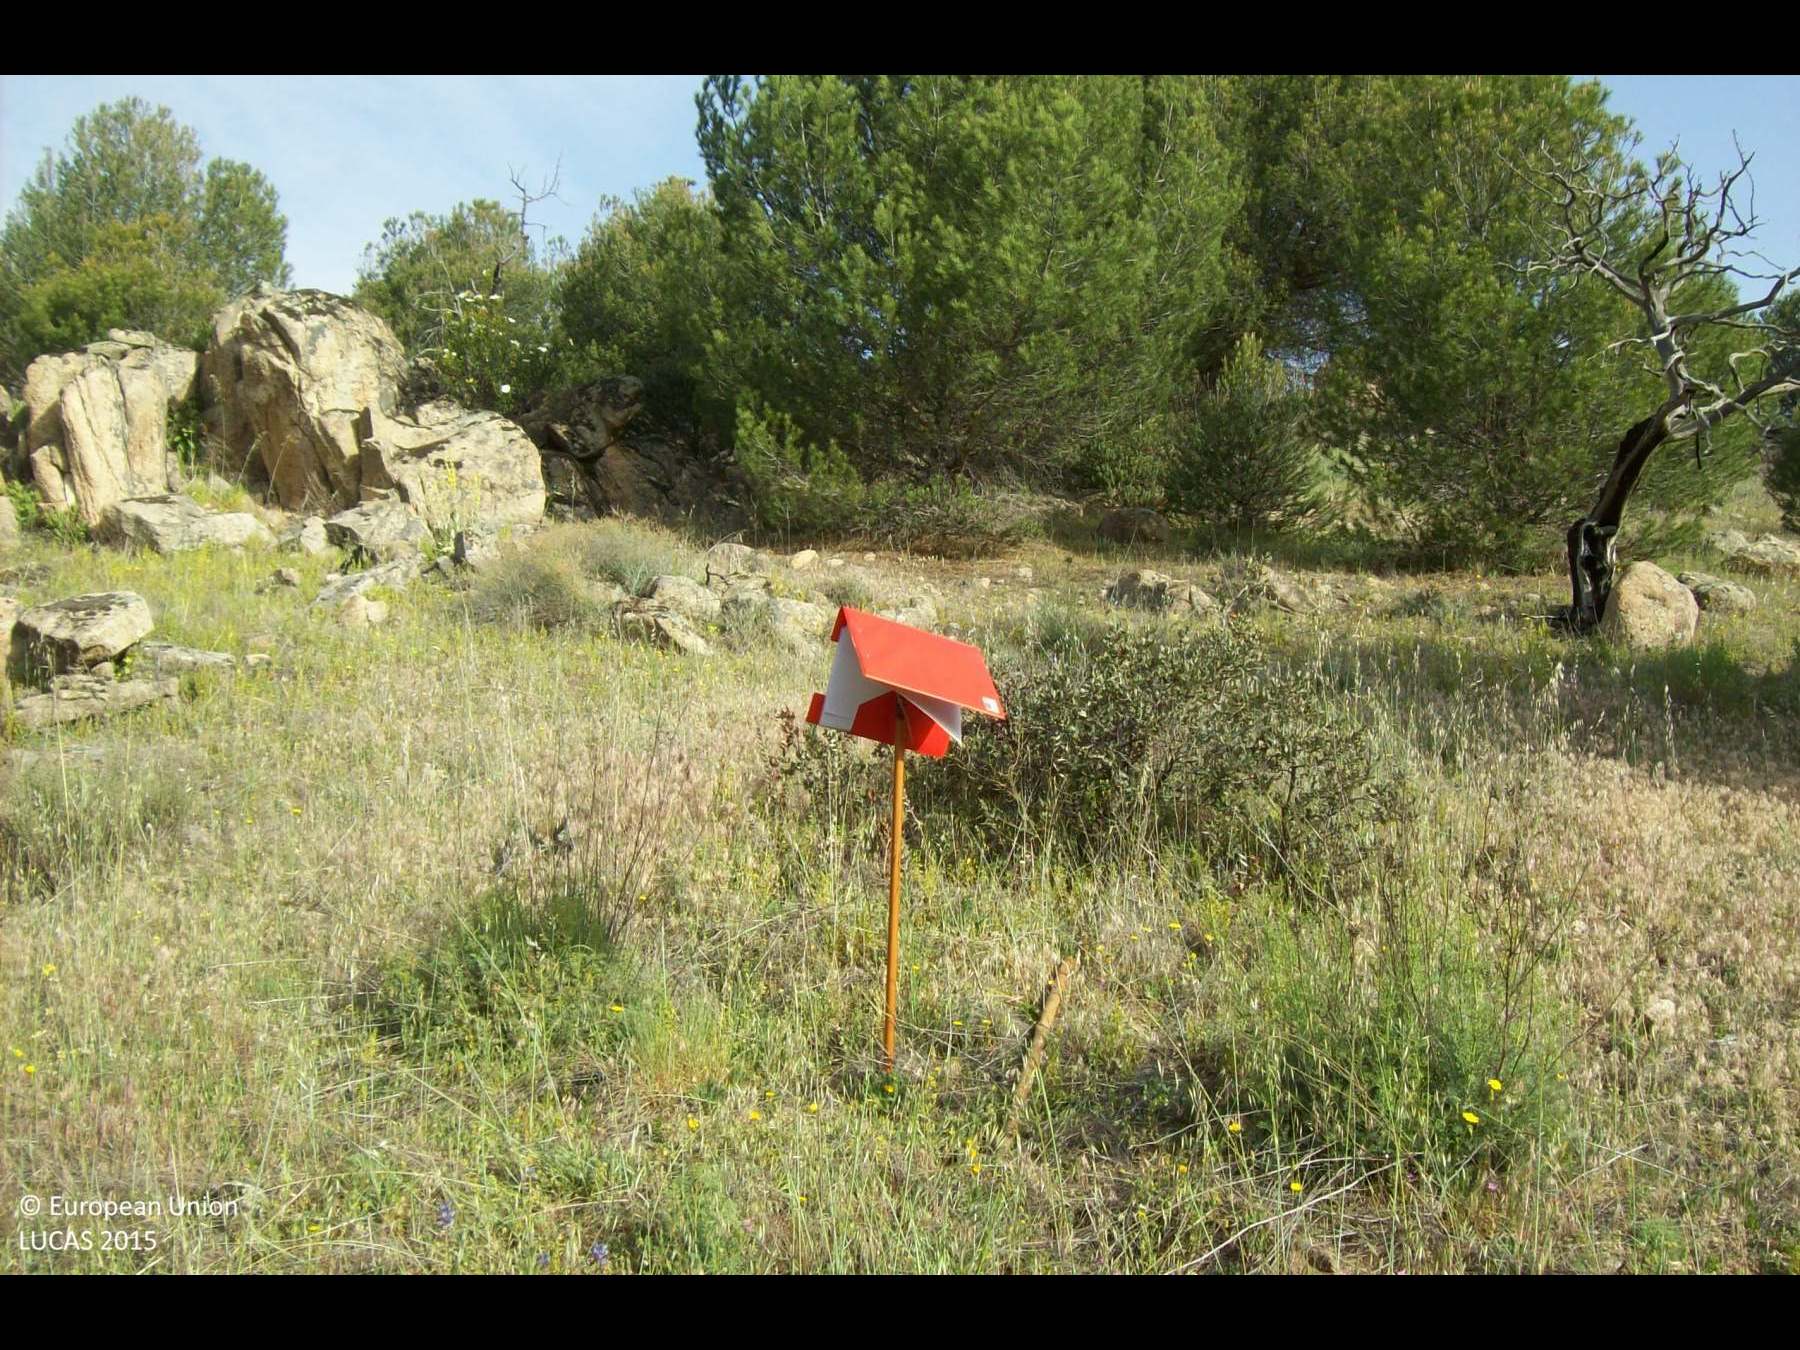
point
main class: Grassland
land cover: Grassland with sparse tree/shrub cover
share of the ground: > 75 %
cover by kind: herbaceous plants 85 %, coniferous forest trees 5 %, shrubs 5 %, consolidated bare surface 5 %
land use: Semi-natural and natural areas not in use
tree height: < 5 m
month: April
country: ES
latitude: 40.5494
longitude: -3.9411
